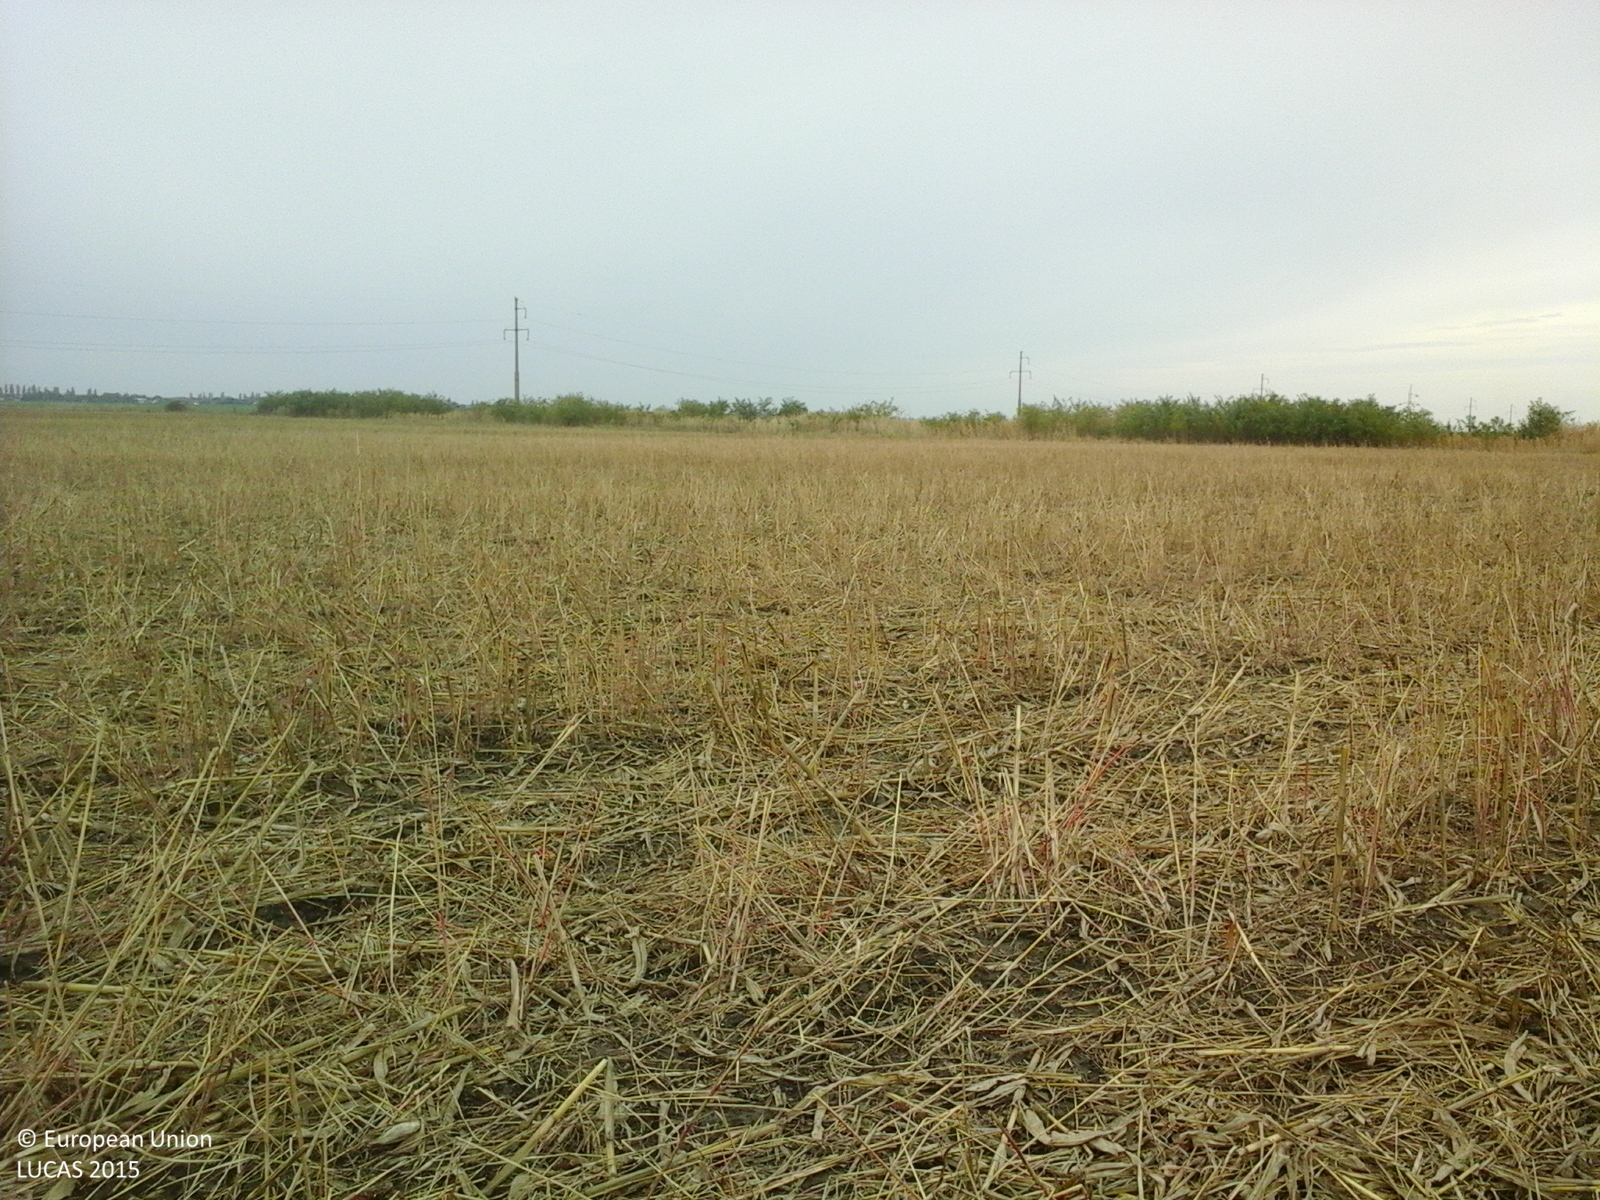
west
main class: Cropland
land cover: Maize
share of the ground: 10 - 25 %
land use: Agriculture (excluding fallow land and kitchen gardens)
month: October
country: RO
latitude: 44.8518
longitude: 26.2977
